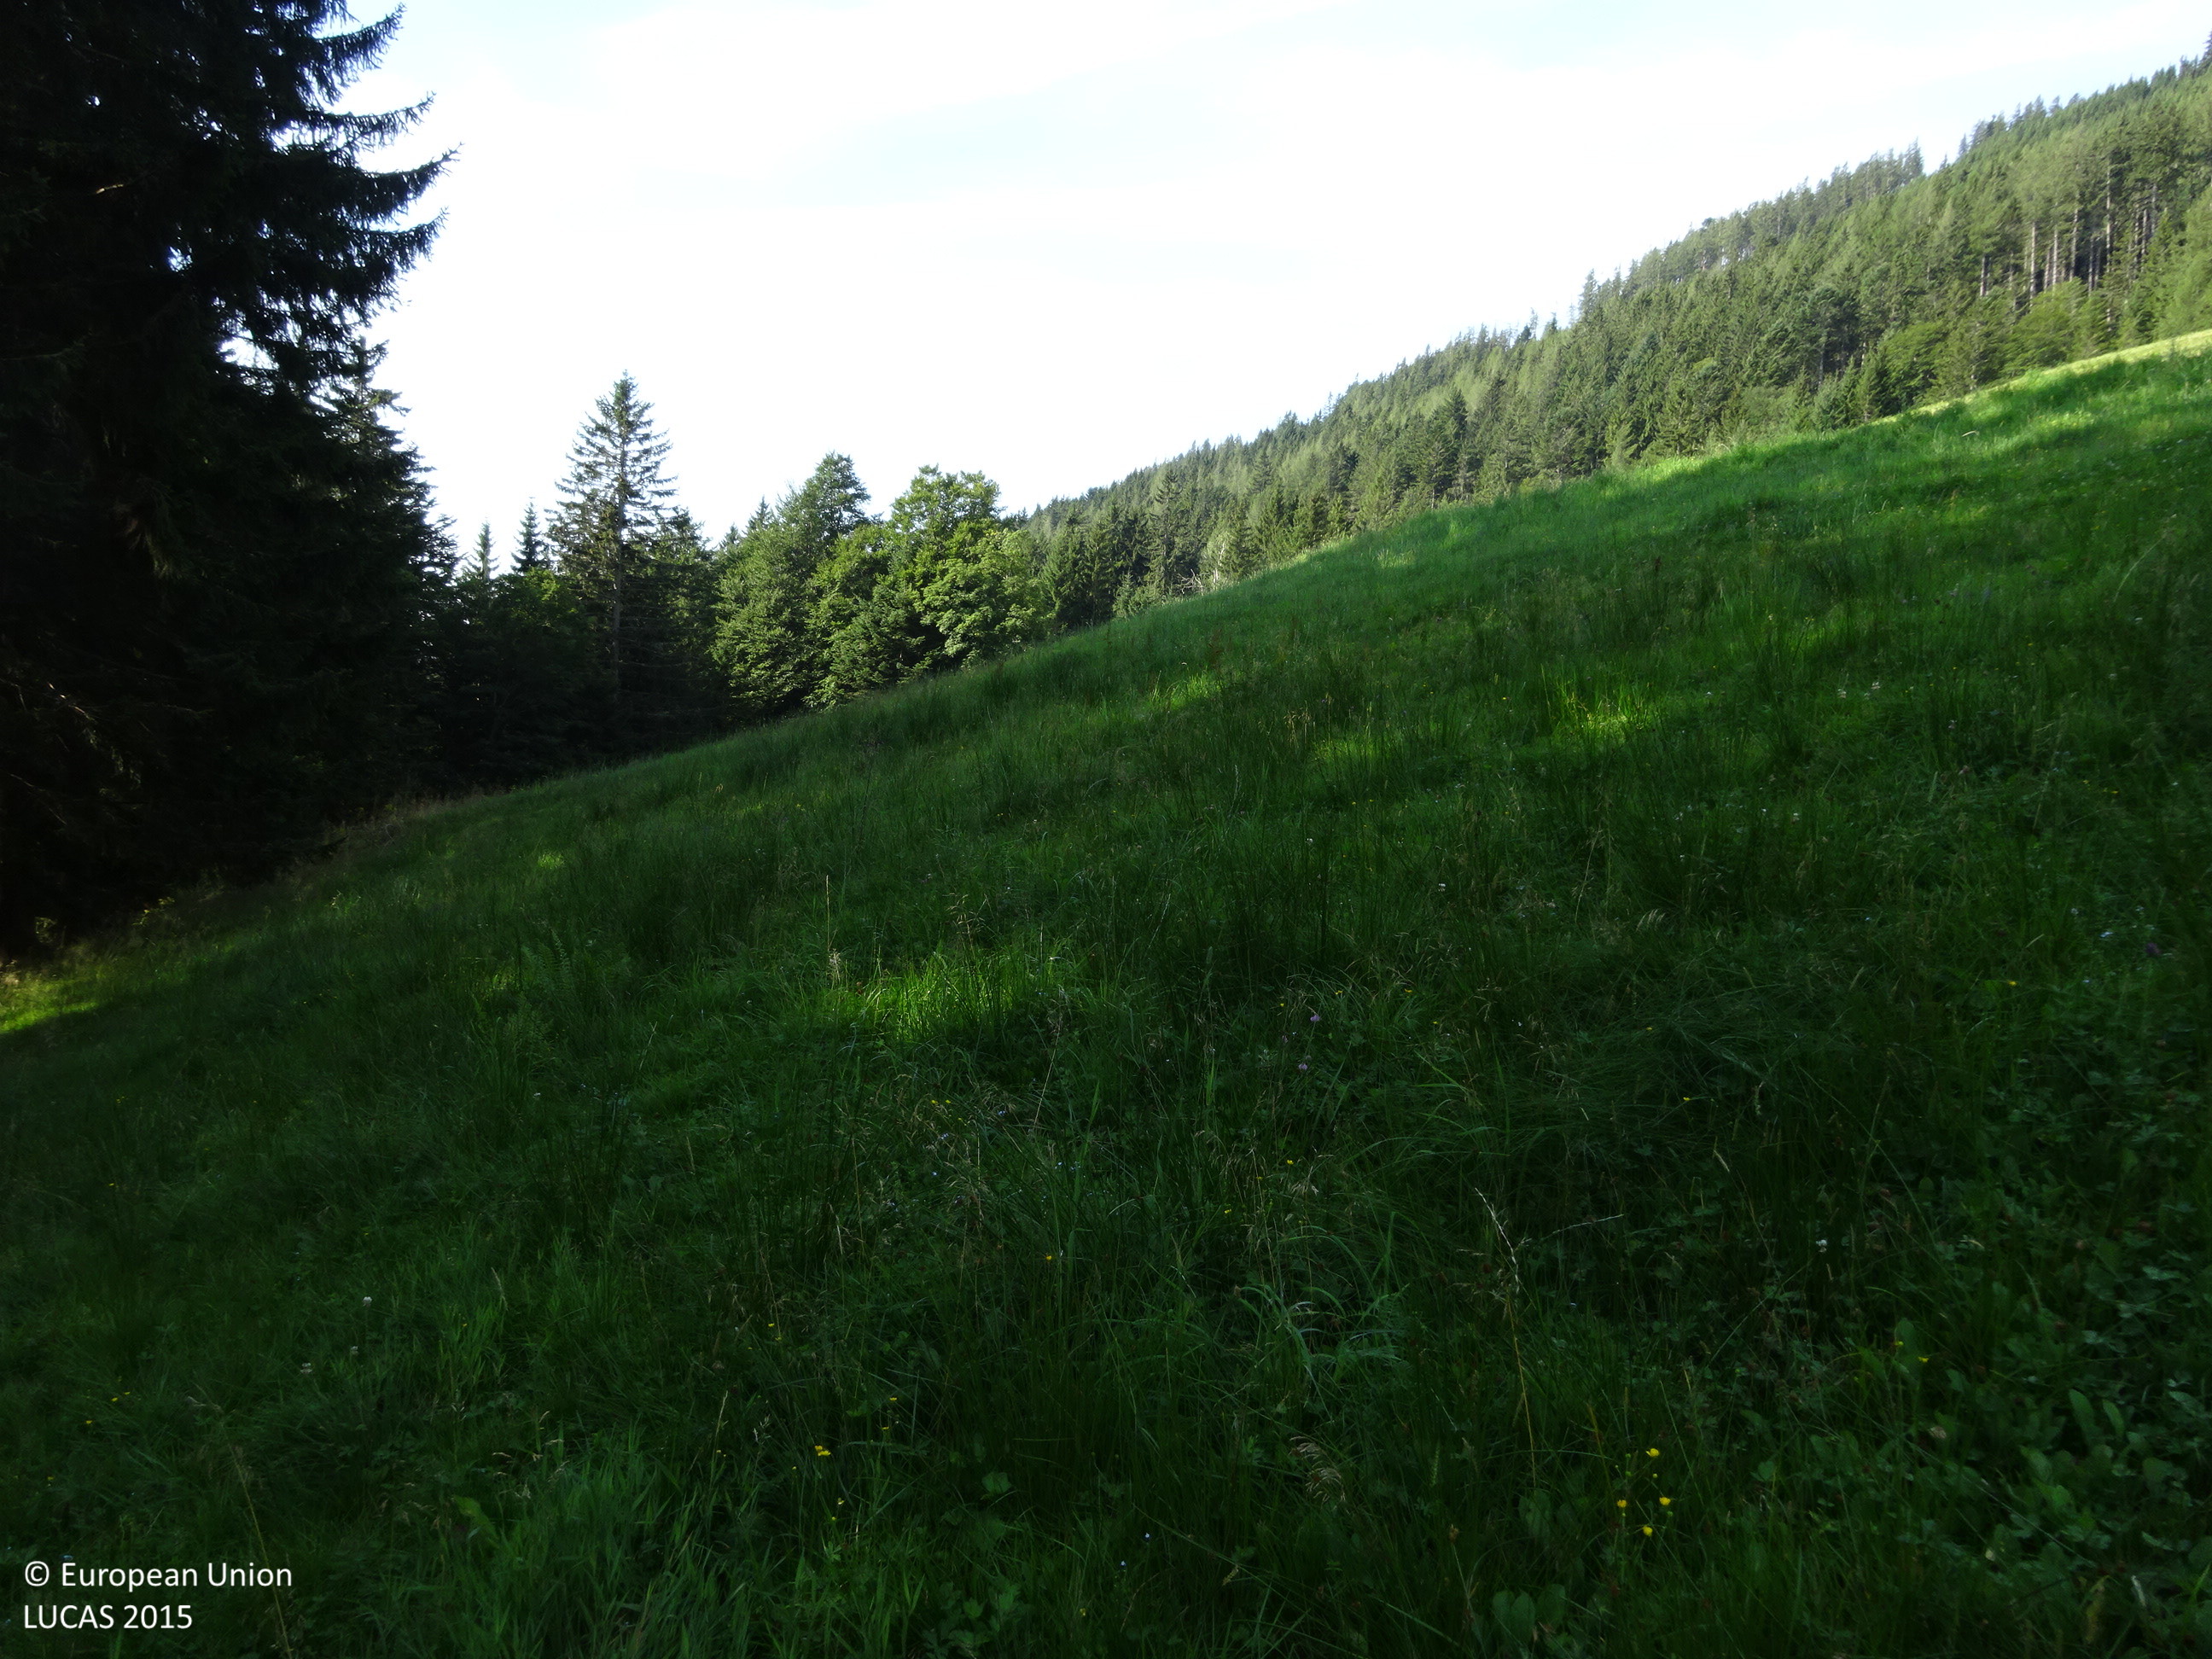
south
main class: Grassland
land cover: Grassland without tree/shrub cover
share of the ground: > 75 %
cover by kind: herbaceous plants 100 %
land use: Agriculture (excluding fallow land and kitchen gardens)
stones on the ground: < 10 %
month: August
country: AT
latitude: 47.5486
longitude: 15.7818
